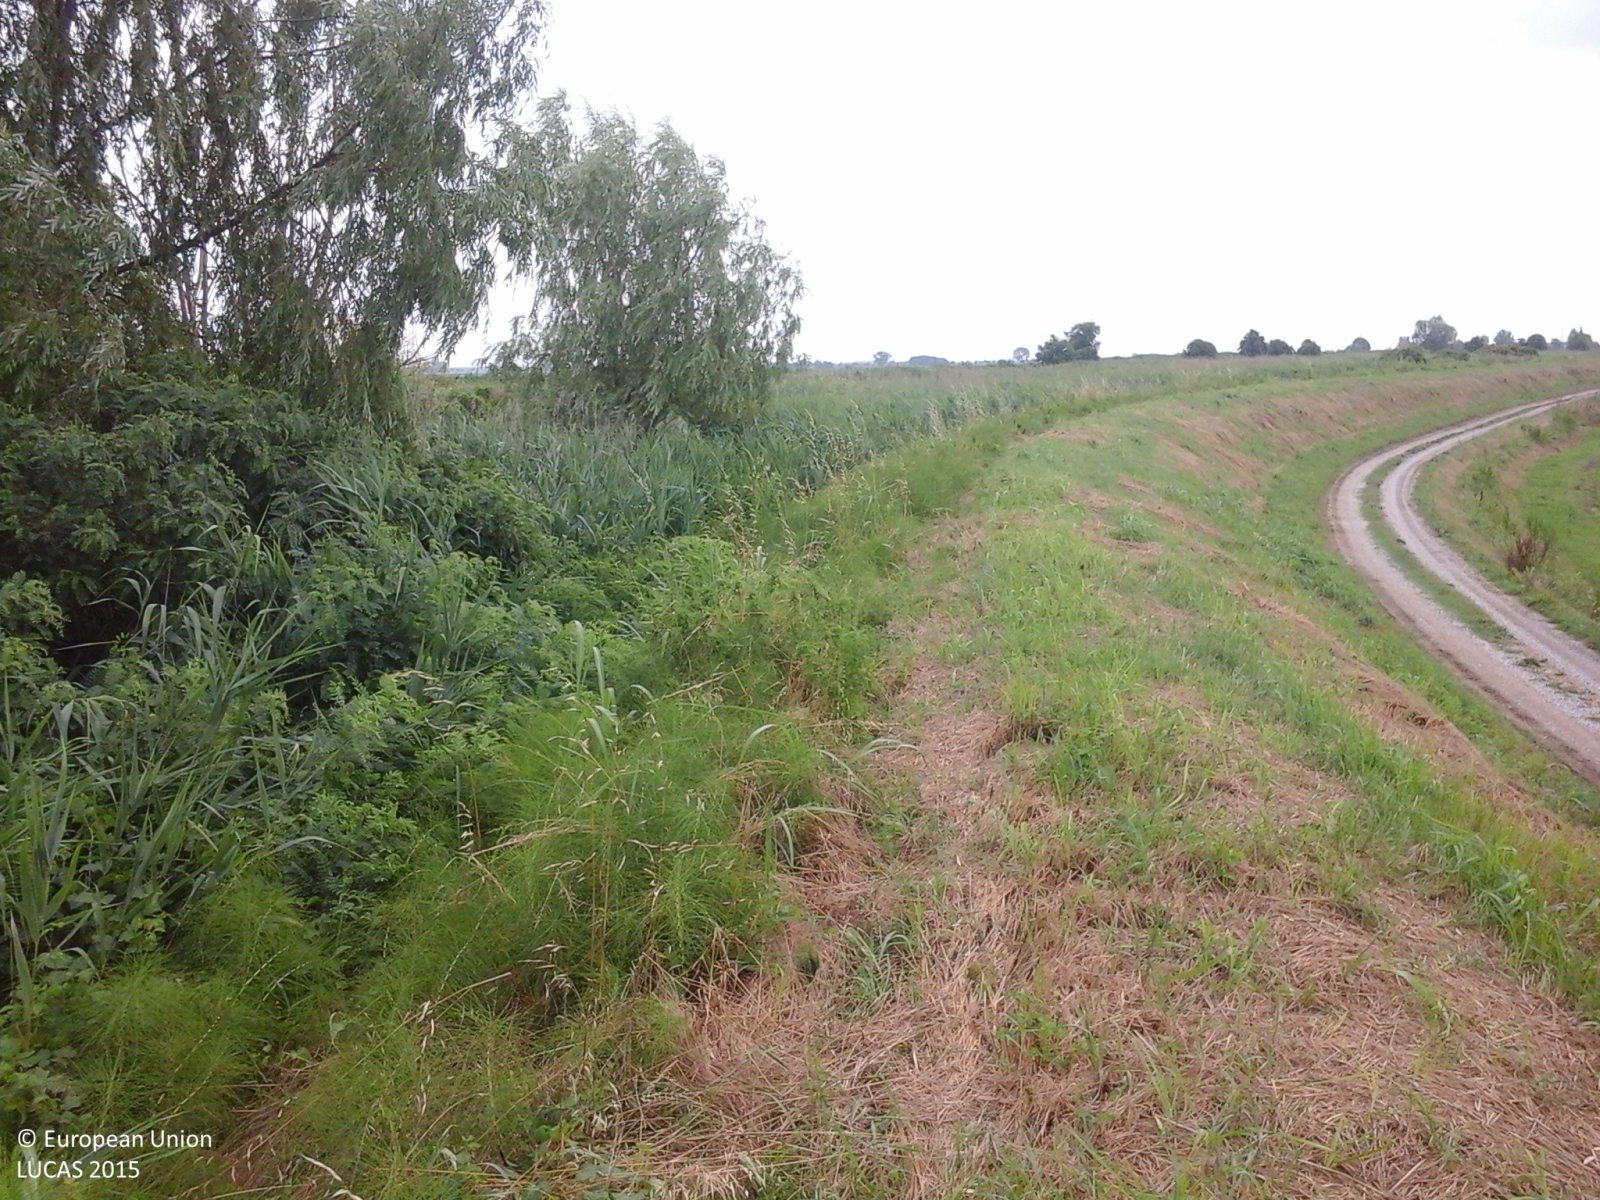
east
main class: Grassland
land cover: Grassland without tree/shrub cover
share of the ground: > 75 %
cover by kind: herbaceous plants 100 %
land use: Protection infrastructures
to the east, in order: Grassland without tree/shrub cover; Broadleaved woodland; Inland marshes; Inland fresh running water; Inland marshes; Grassland without tree/shrub cover; Tracks; Arable land (only in case pi); Ditches and canals; Arable land (only in case pi)
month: June
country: IT
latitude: 45.7208
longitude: 12.7586
